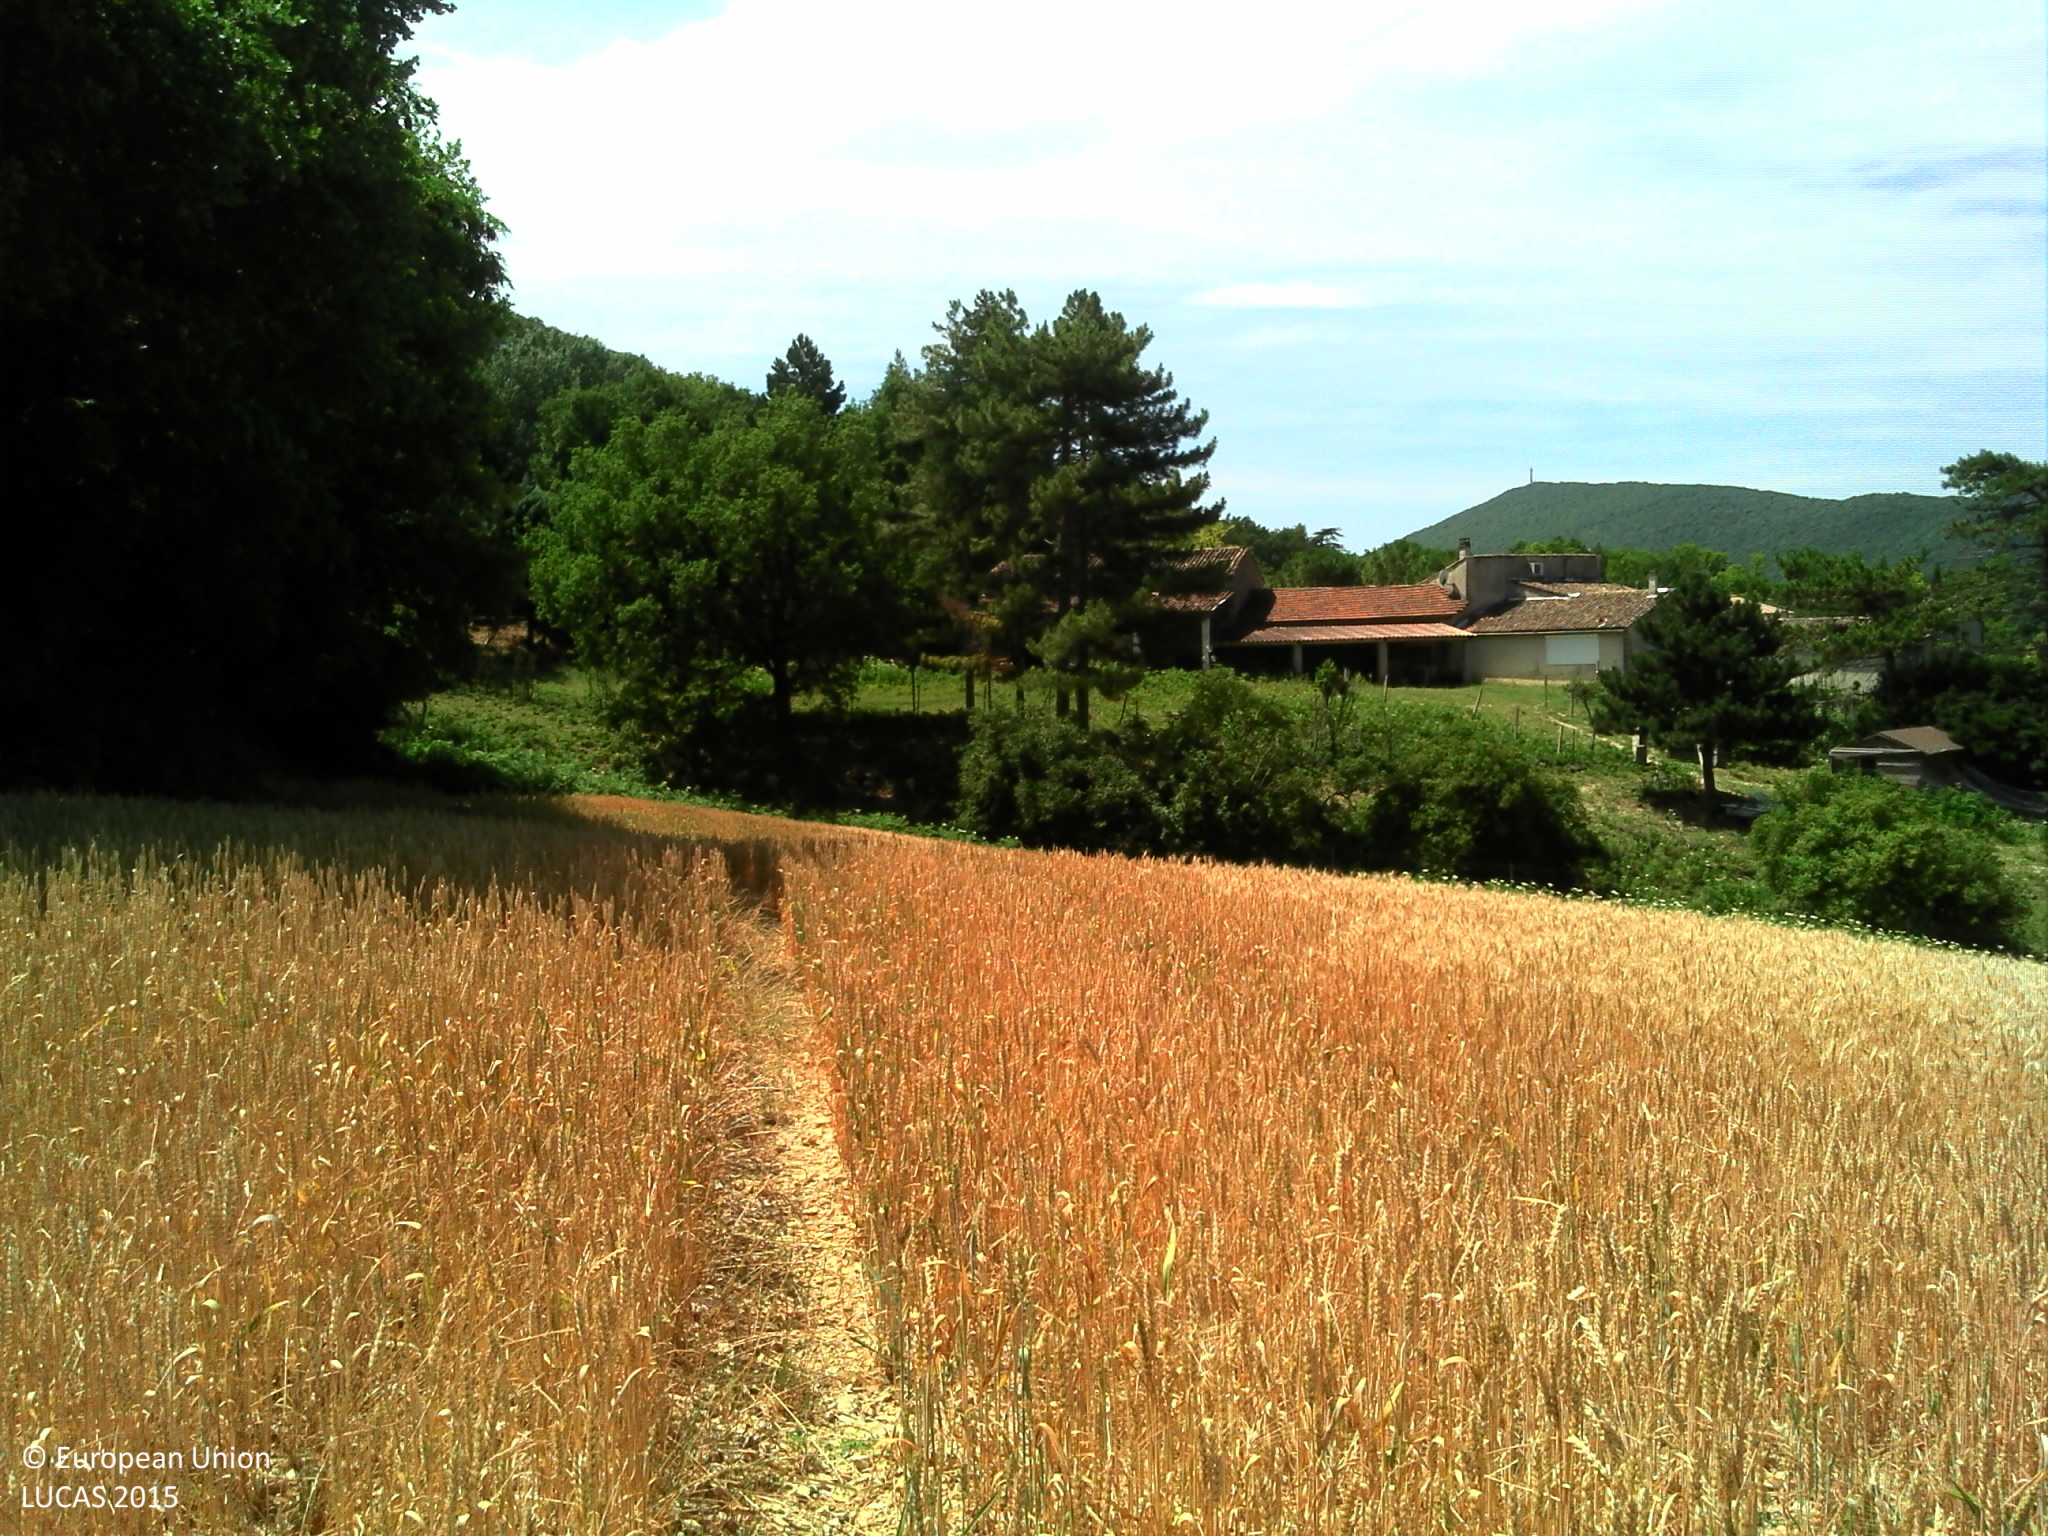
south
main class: Cropland
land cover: Common wheat
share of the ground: > 75 %
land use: Agriculture (excluding fallow land and kitchen gardens)
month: June
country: FR
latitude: 44.6358
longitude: 4.8001
